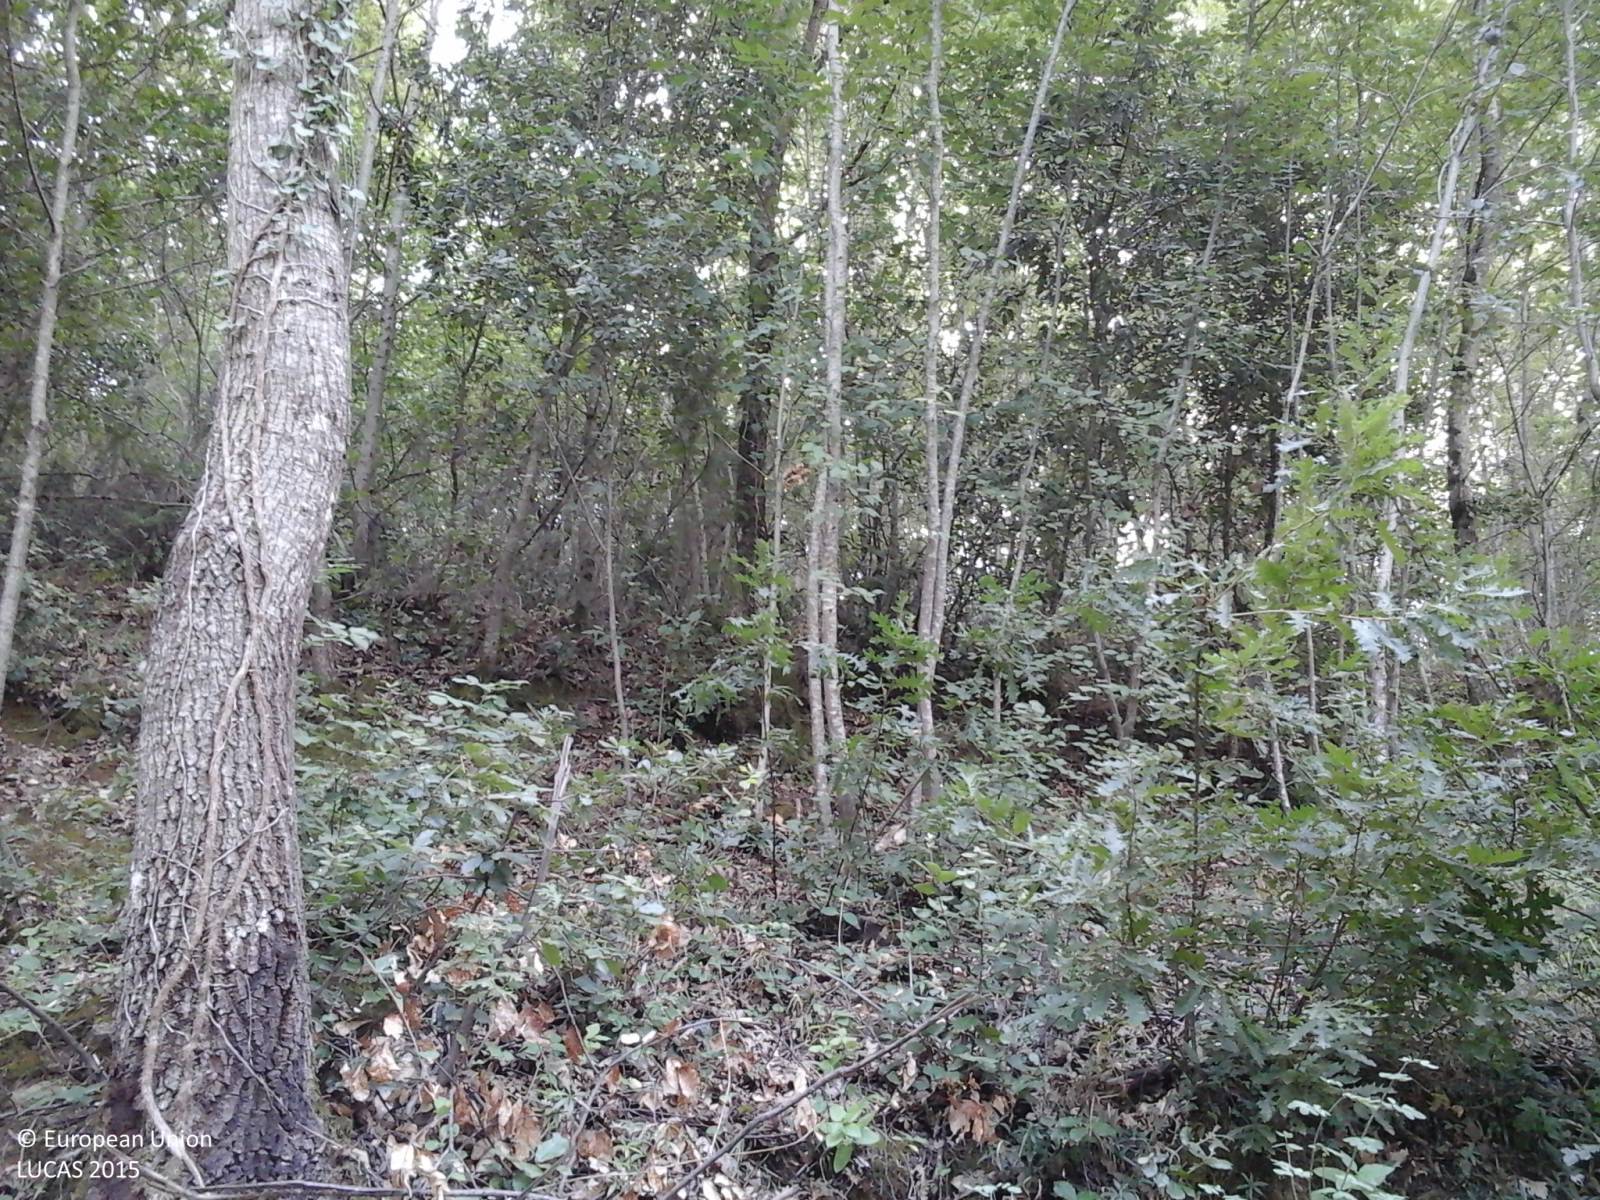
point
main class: Woodland
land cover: Broadleaved woodland
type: mesophytic deciduous forest
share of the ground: > 75 %
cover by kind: broadleaved forest trees 95 %, shrubs 5 %
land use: Forestry
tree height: > 5 m
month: September
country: IT
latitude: 43.0123
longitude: 12.0673
